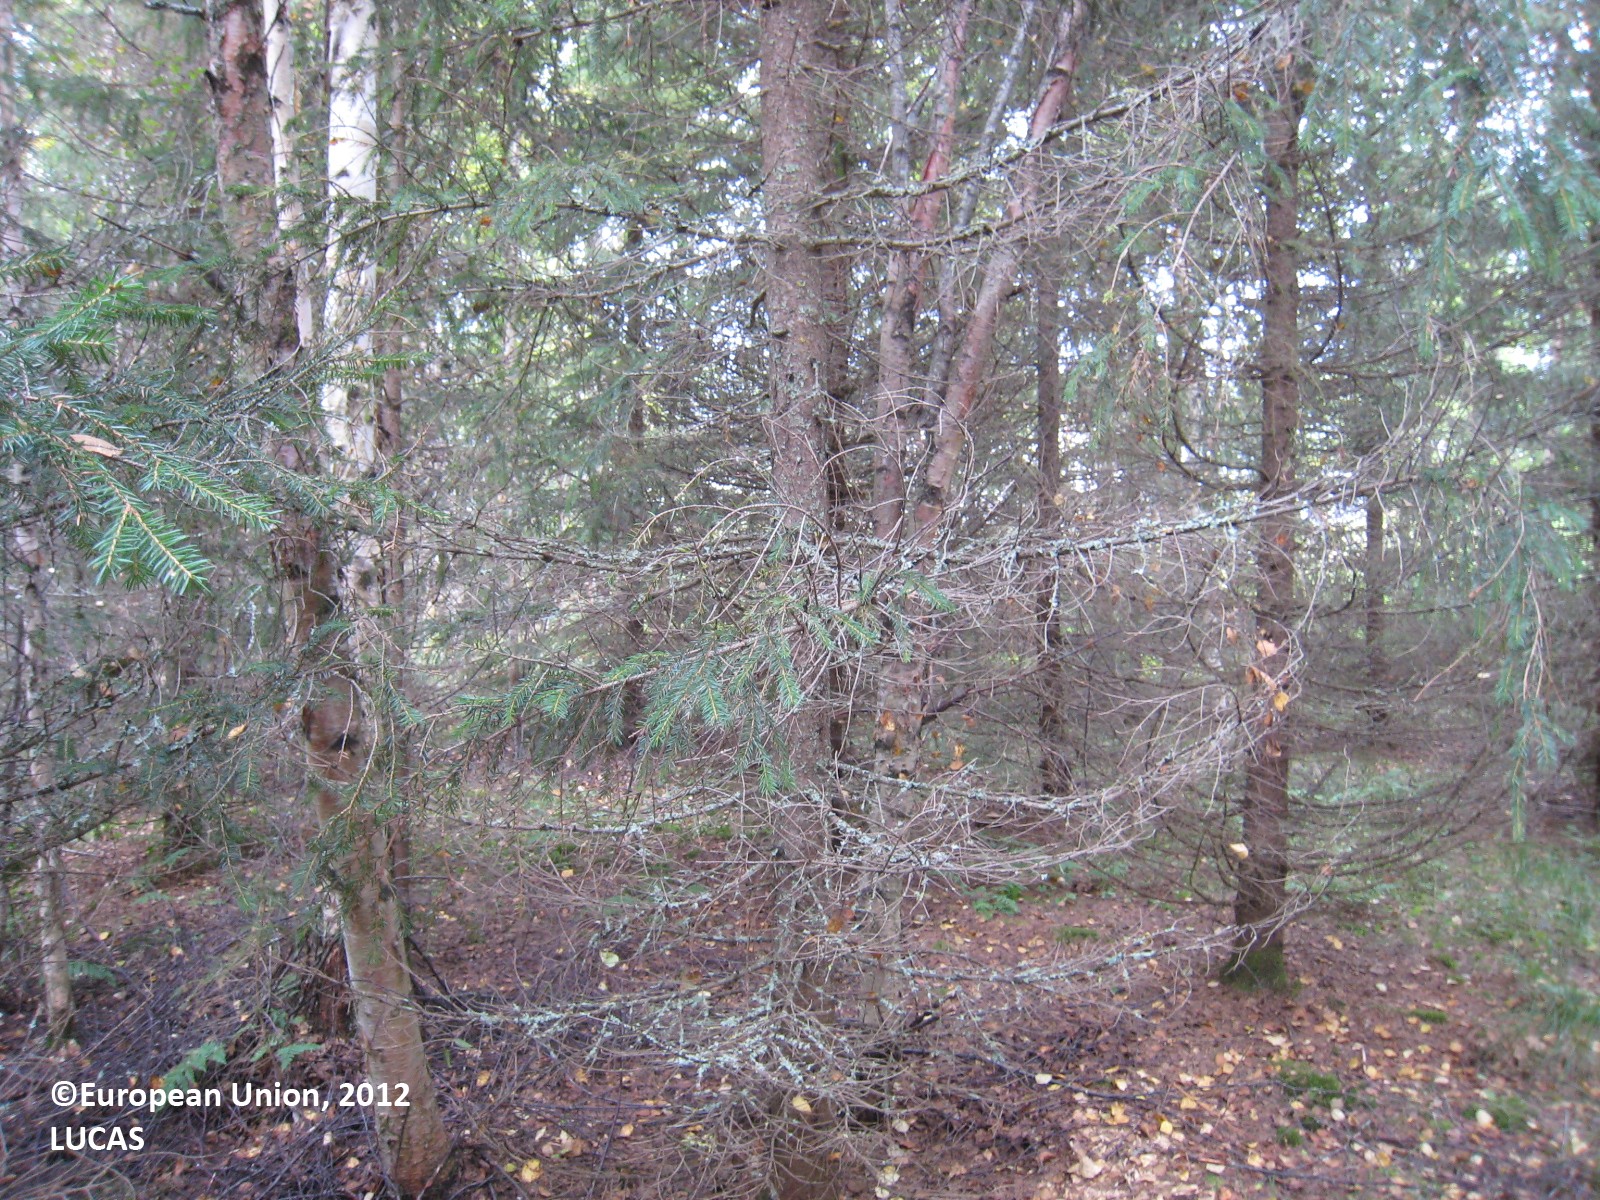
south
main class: Woodland
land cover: Spruce dominated mixed woodland
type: boreal forest
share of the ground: > 75 %
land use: Forestry
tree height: > 5 m
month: August
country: FI
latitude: 62.2936
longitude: 27.3824
